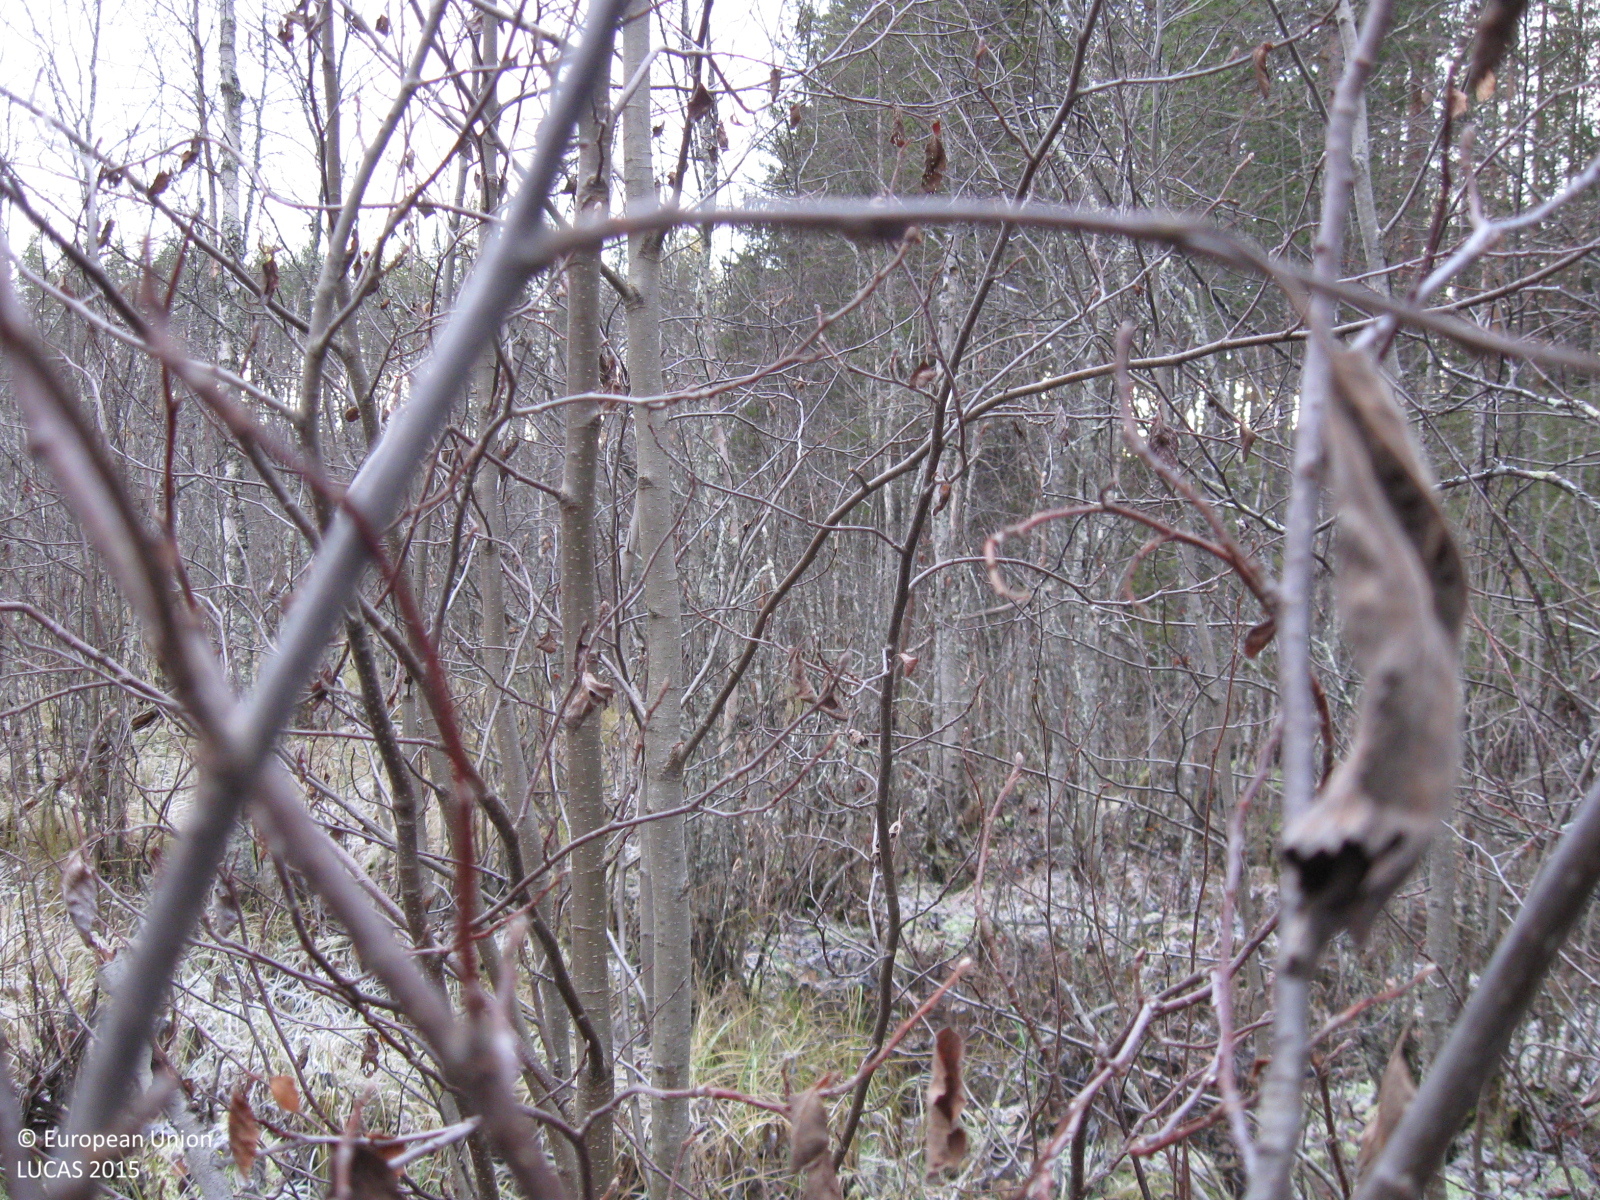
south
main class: Woodland
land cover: Broadleaved woodland
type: mire and swamp forests
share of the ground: > 75 %
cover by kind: broadleaved forest trees 75 %, herbaceous plants 10 %, lichens and mosses 10 %
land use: Semi-natural and natural areas not in use
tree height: < 5 m
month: October
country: SE
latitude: 66.1680
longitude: 21.6115
